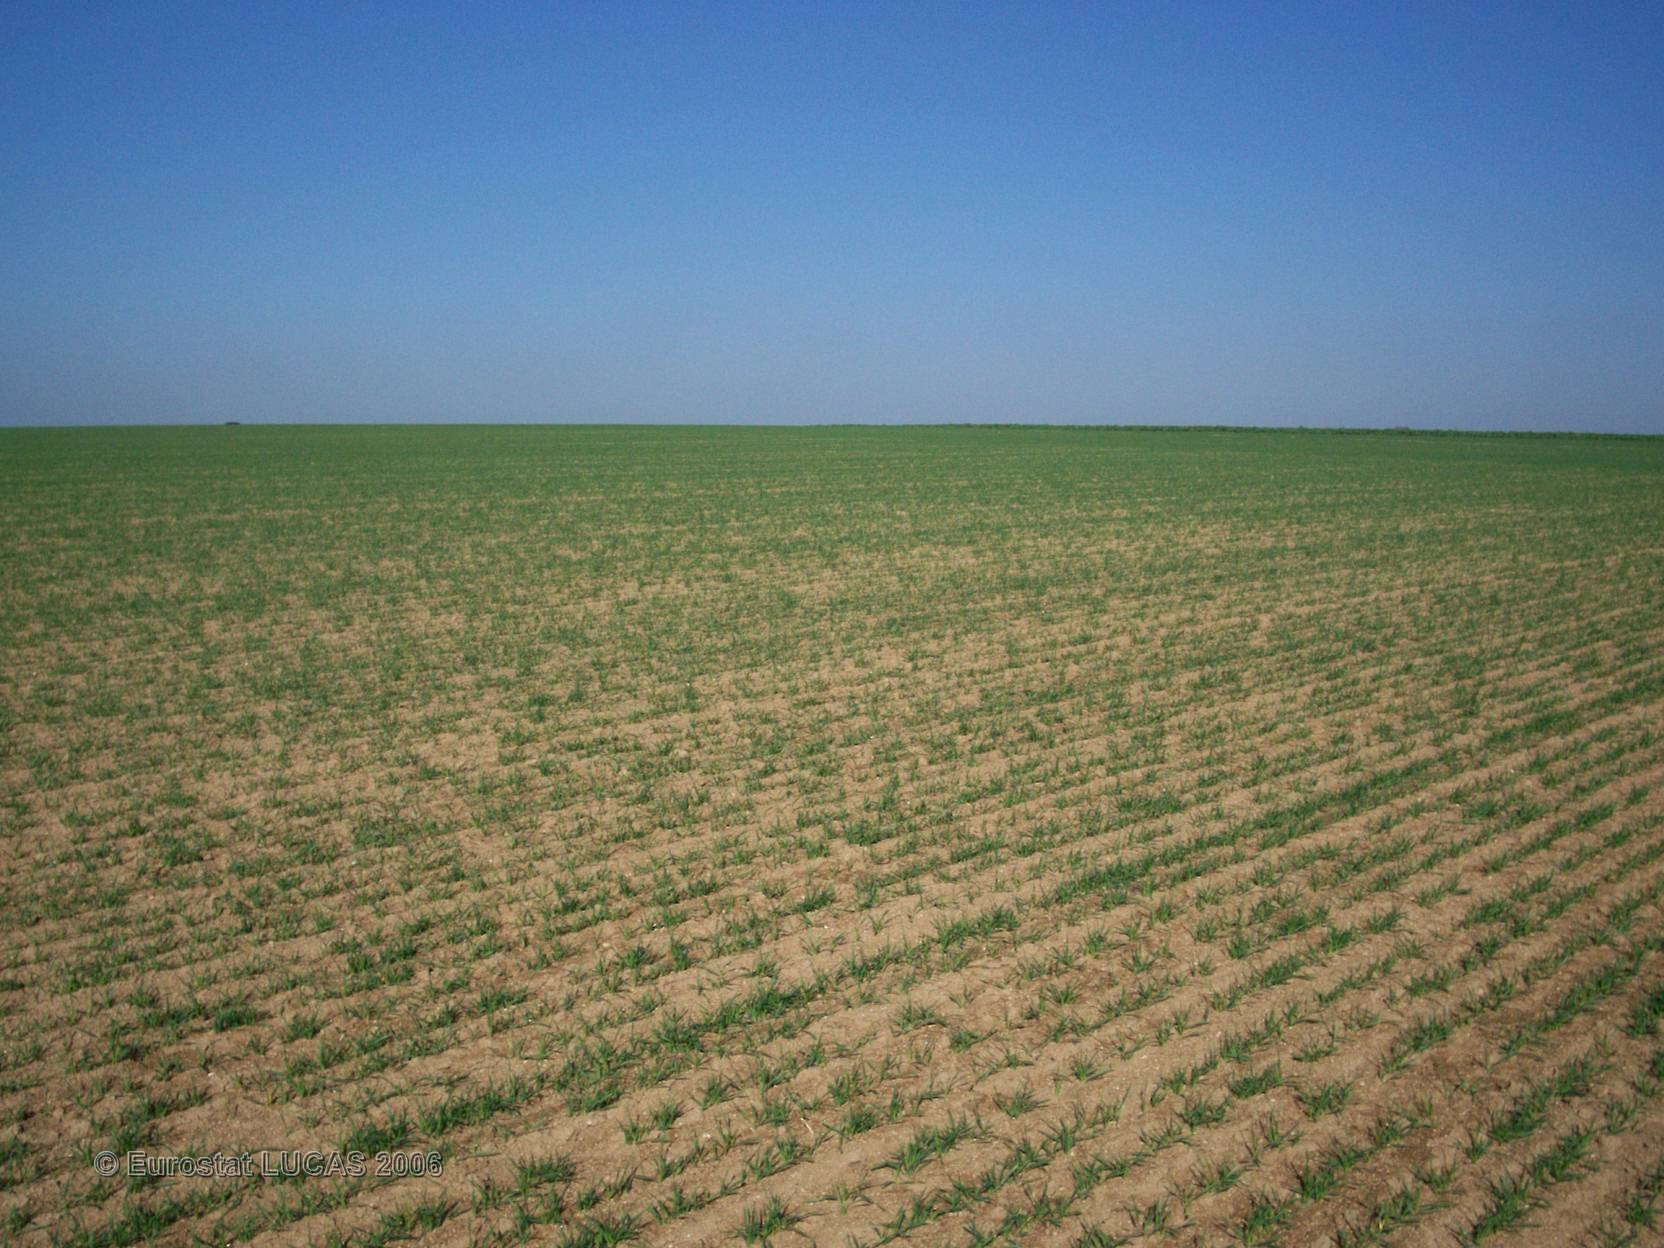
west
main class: Cropland
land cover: Barley
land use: Agriculture (excluding fallow land and kitchen gardens)
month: April
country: FR
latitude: 48.5337
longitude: 4.4310
